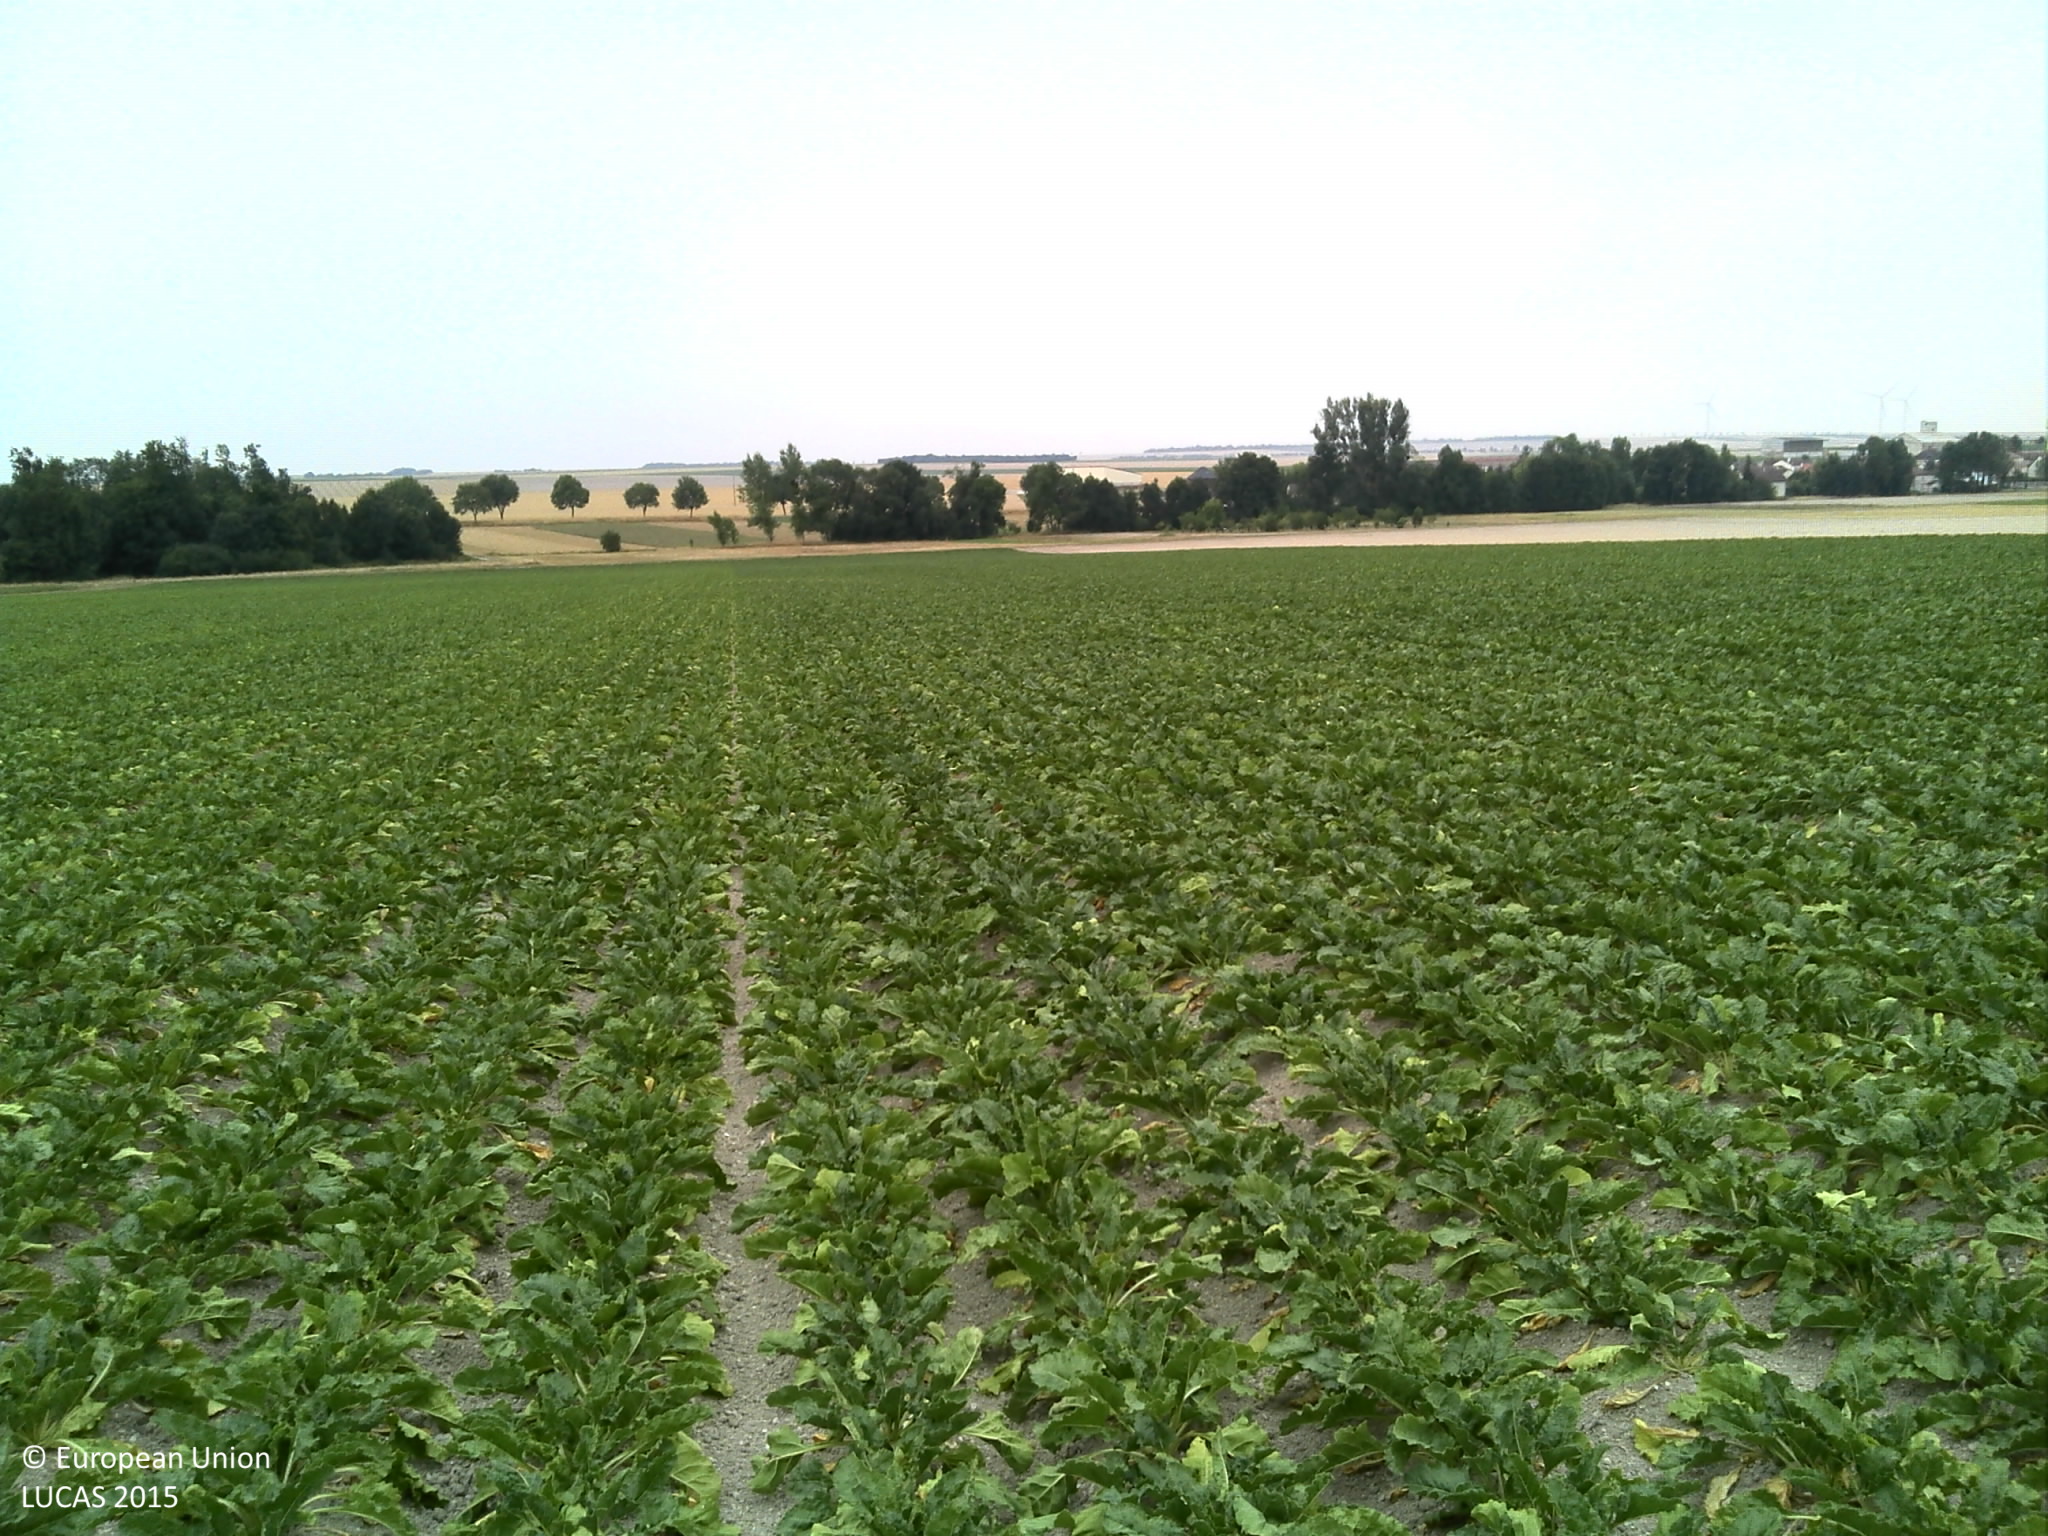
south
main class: Cropland
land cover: Sugar beet
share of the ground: 50 - 75 %
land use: Agriculture (excluding fallow land and kitchen gardens)
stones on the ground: < 10 %
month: August
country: FR
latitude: 48.9378
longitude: 4.2212
